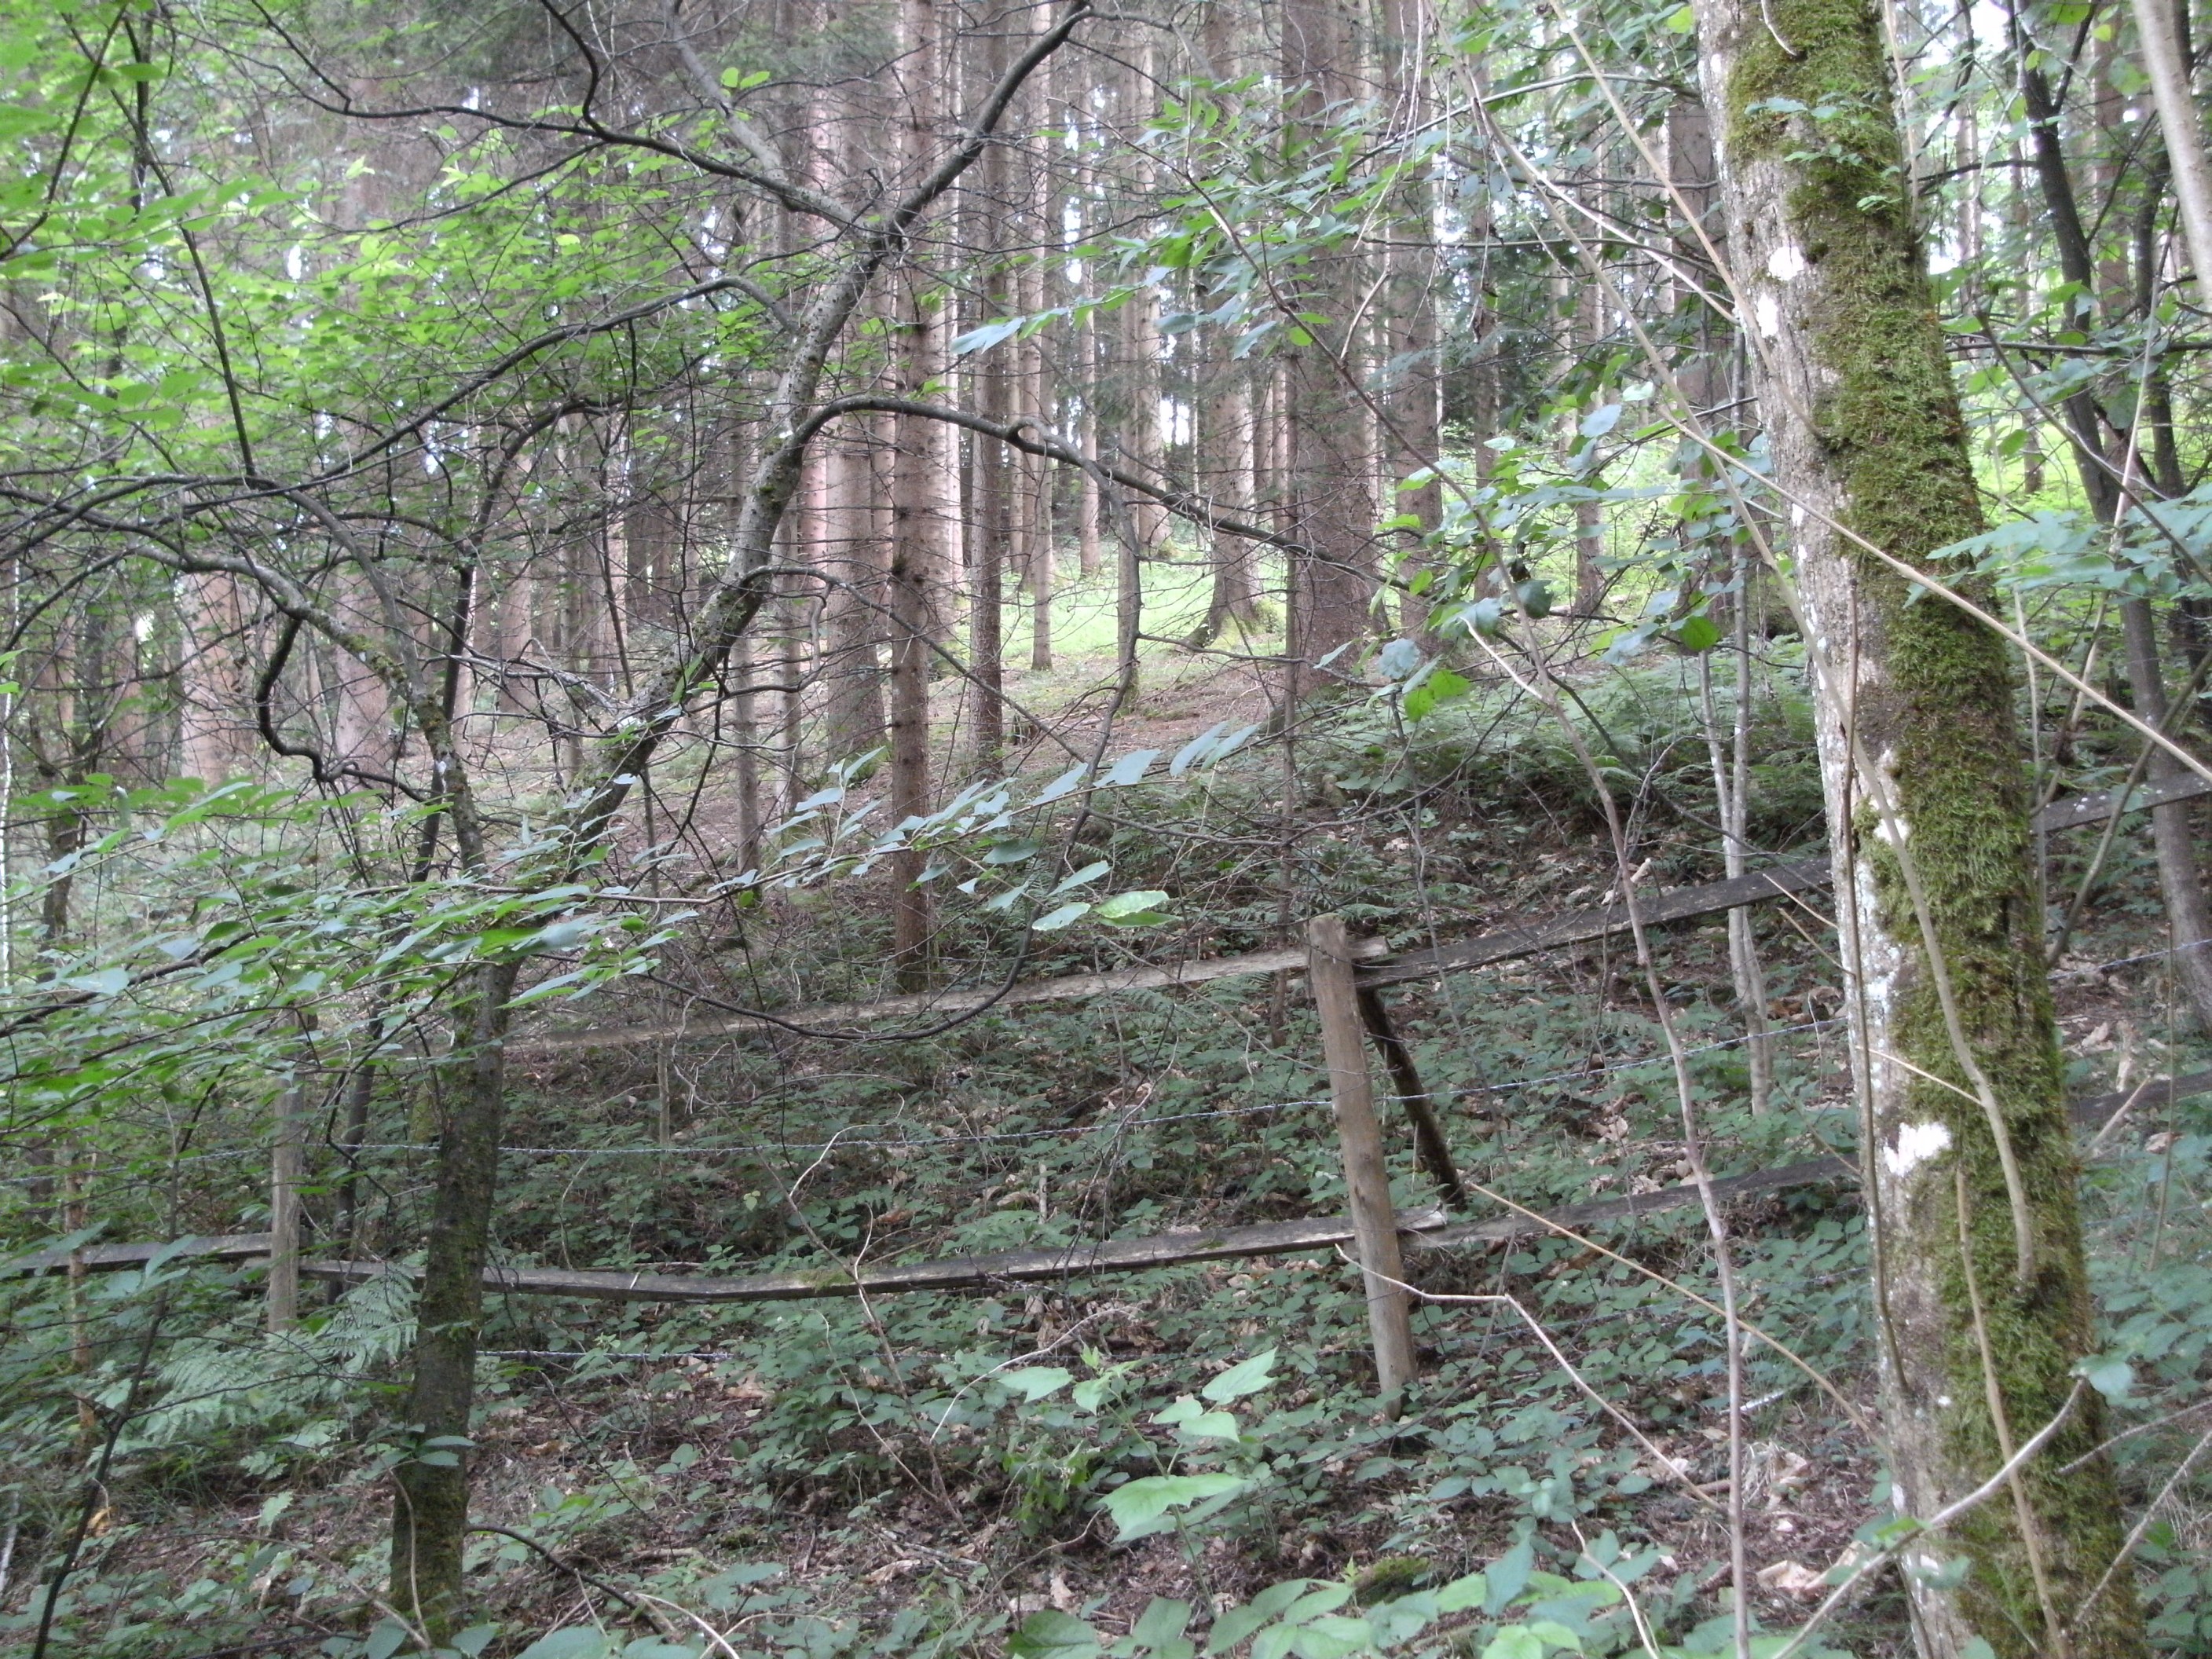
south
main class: Woodland
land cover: Spruce dominated mixed woodland
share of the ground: > 75 %
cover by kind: coniferous forest trees 40 %, broadleaved forest trees 40 %, shrubs 10 %, herbaceous plants 10 %
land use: Forestry
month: July
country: AT
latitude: 46.8036
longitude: 14.7809
